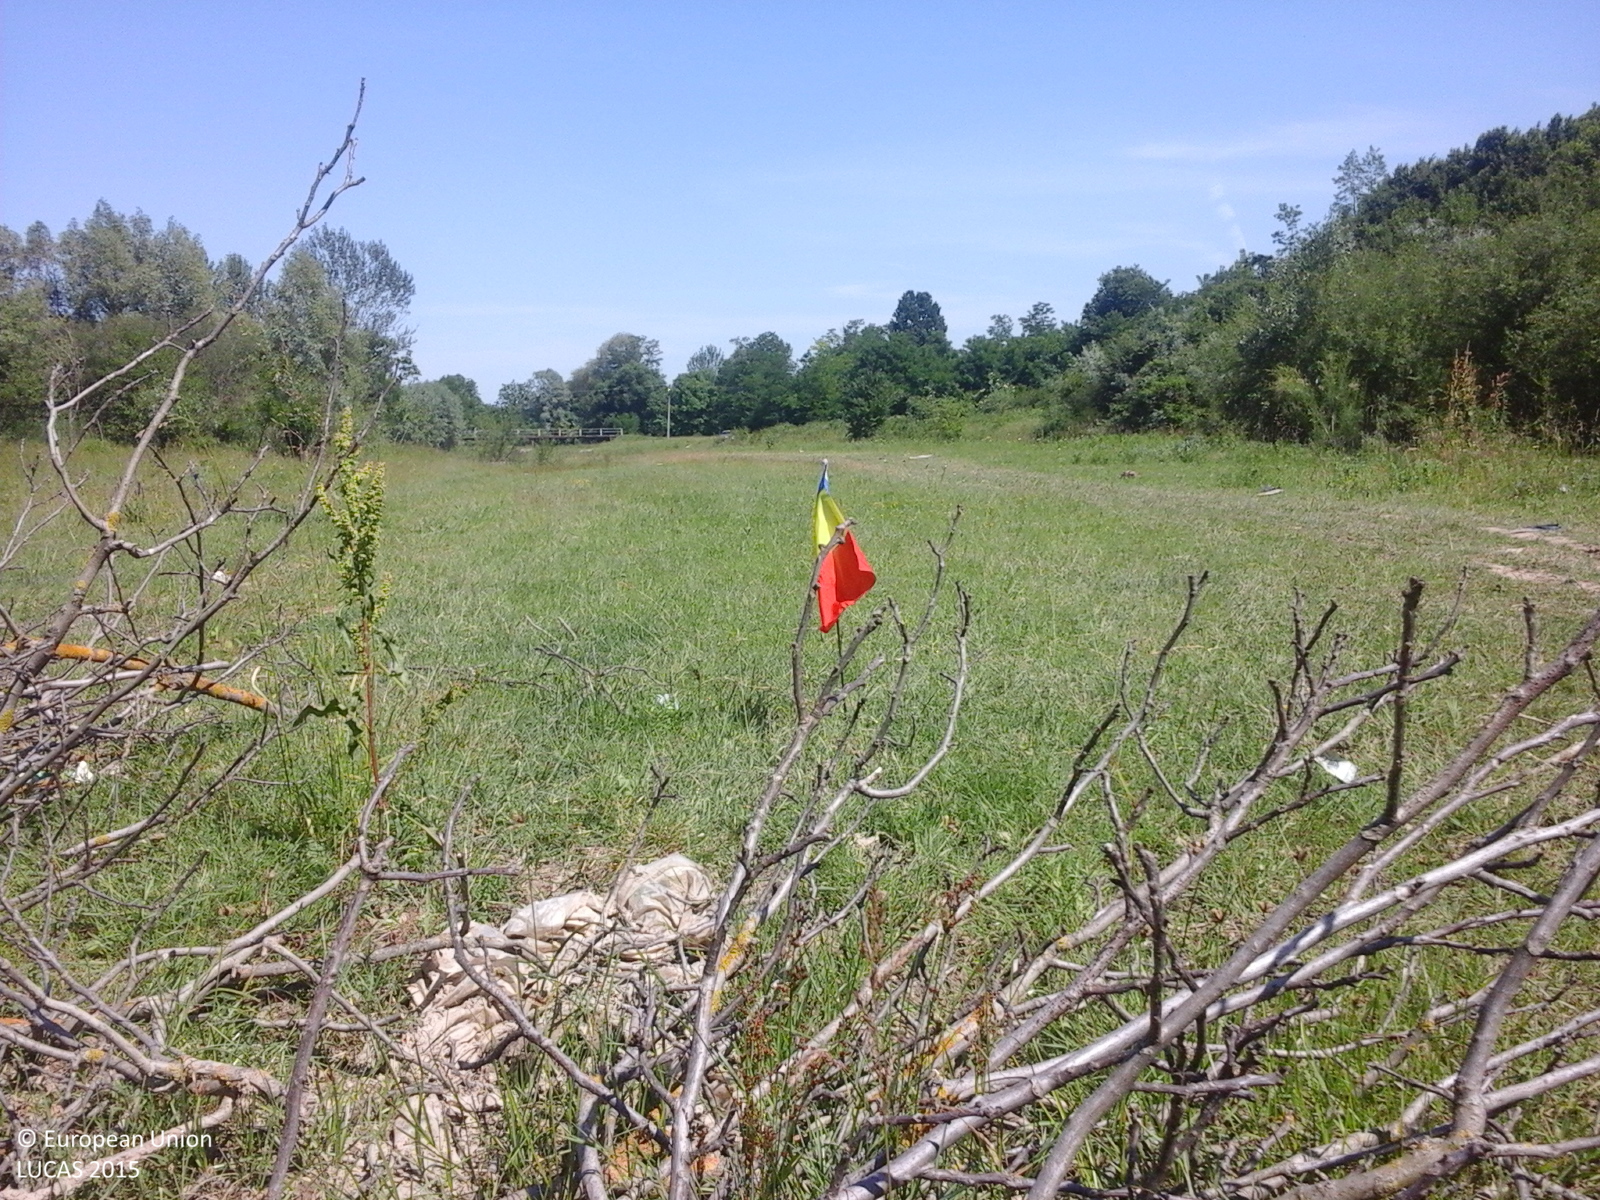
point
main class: Grassland
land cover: Grassland with sparse tree/shrub cover
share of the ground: > 75 %
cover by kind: herbaceous plants 85 %, shrubs 10 %, broadleaved forest trees 5 %
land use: Agriculture (excluding fallow land and kitchen gardens)
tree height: < 5 m
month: June
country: RO
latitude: 45.1149
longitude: 26.1417
